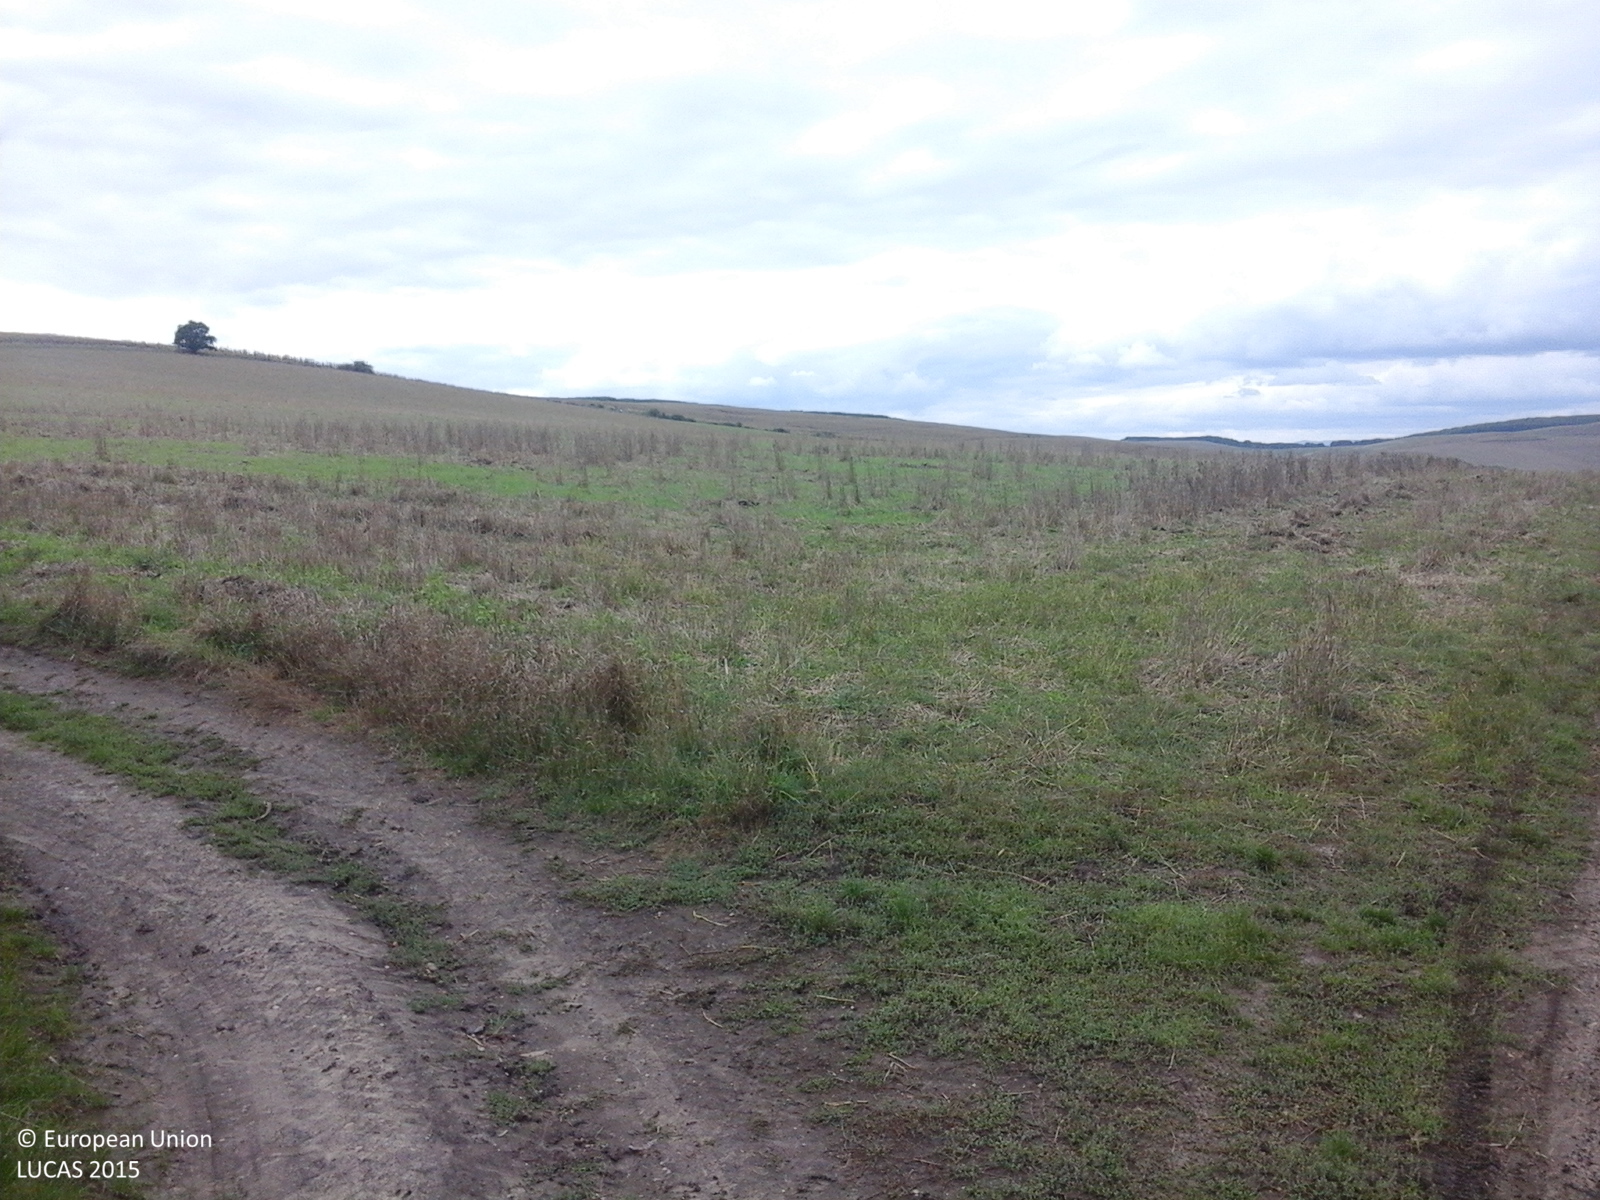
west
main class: Cropland
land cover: Maize
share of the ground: > 75 %
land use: Agriculture (excluding fallow land and kitchen gardens)
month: September
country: RO
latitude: 45.9536
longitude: 23.7311
